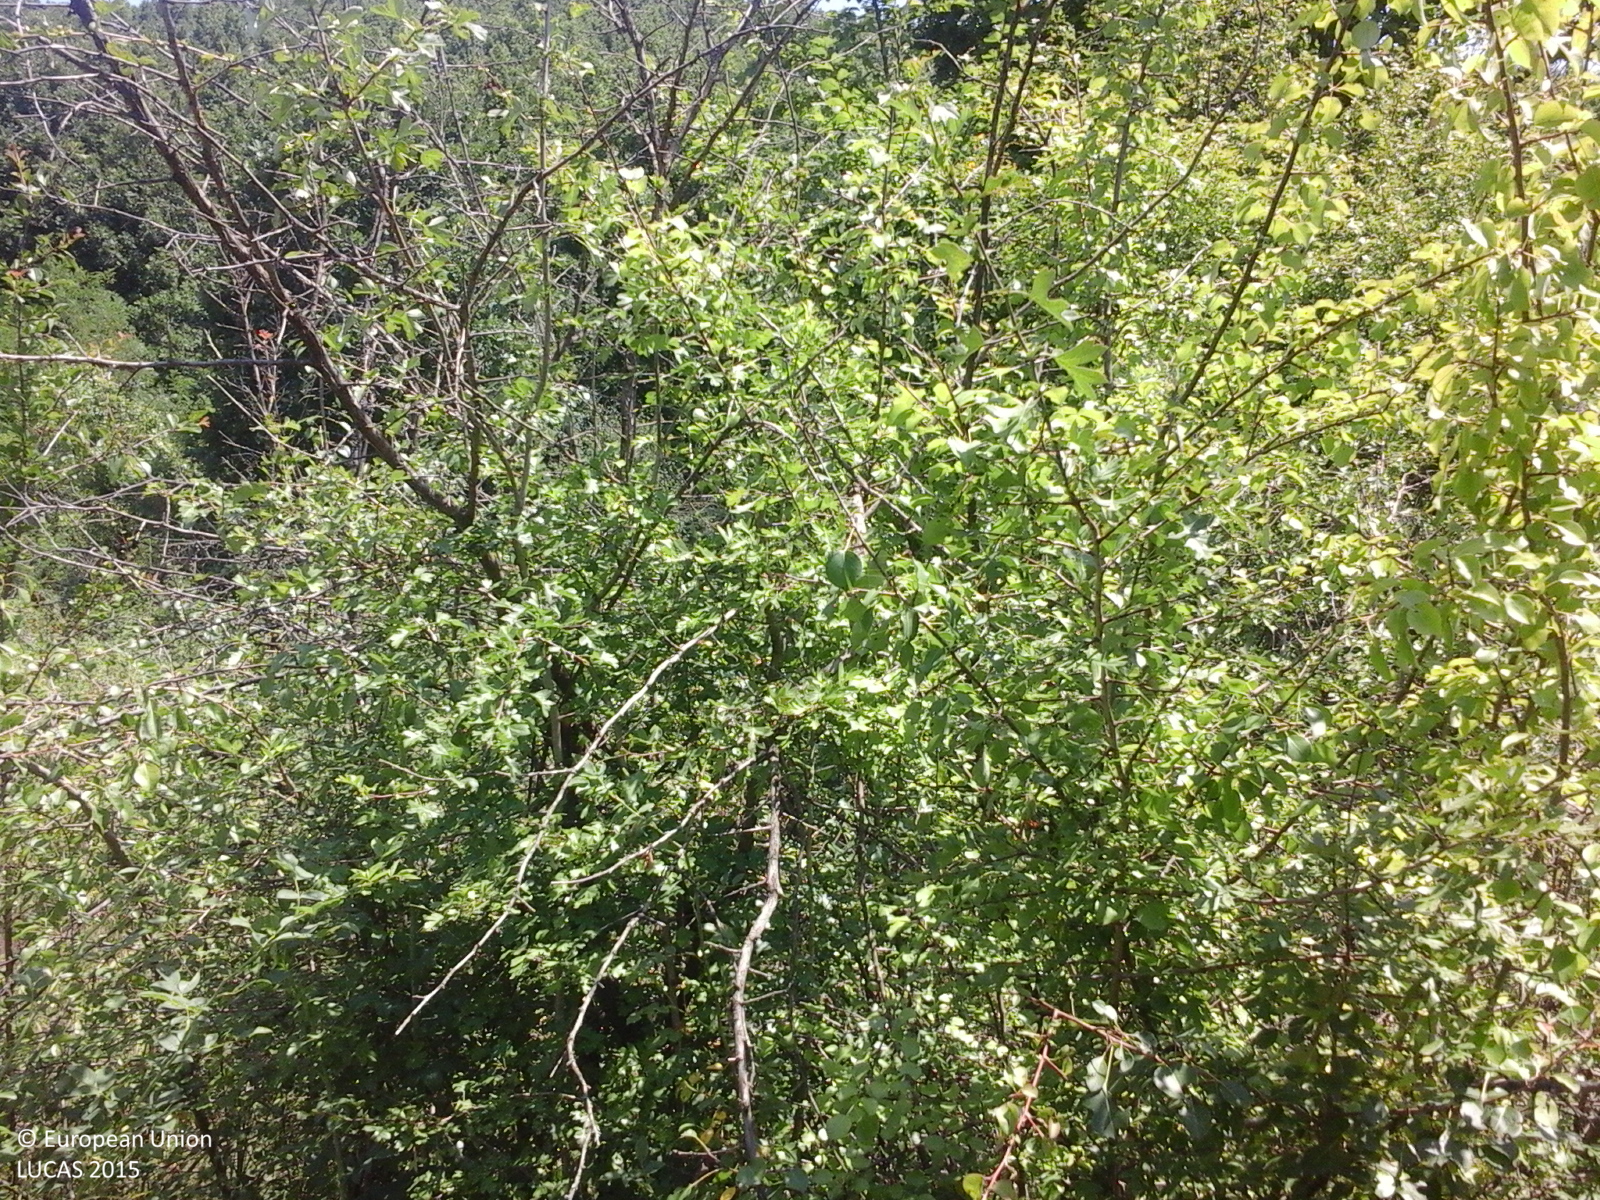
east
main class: Shrubland
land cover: Shrubland with sparse tree cover
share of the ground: > 75 %
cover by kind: shrubs 85 %, herbaceous plants 10 %, broadleaved forest trees 5 %
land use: Semi-natural and natural areas not in use
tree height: < 5 m
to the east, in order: Shrubland with sparse tree cover; Broadleaved woodland
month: July
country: RO
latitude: 44.6737
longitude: 24.4136
